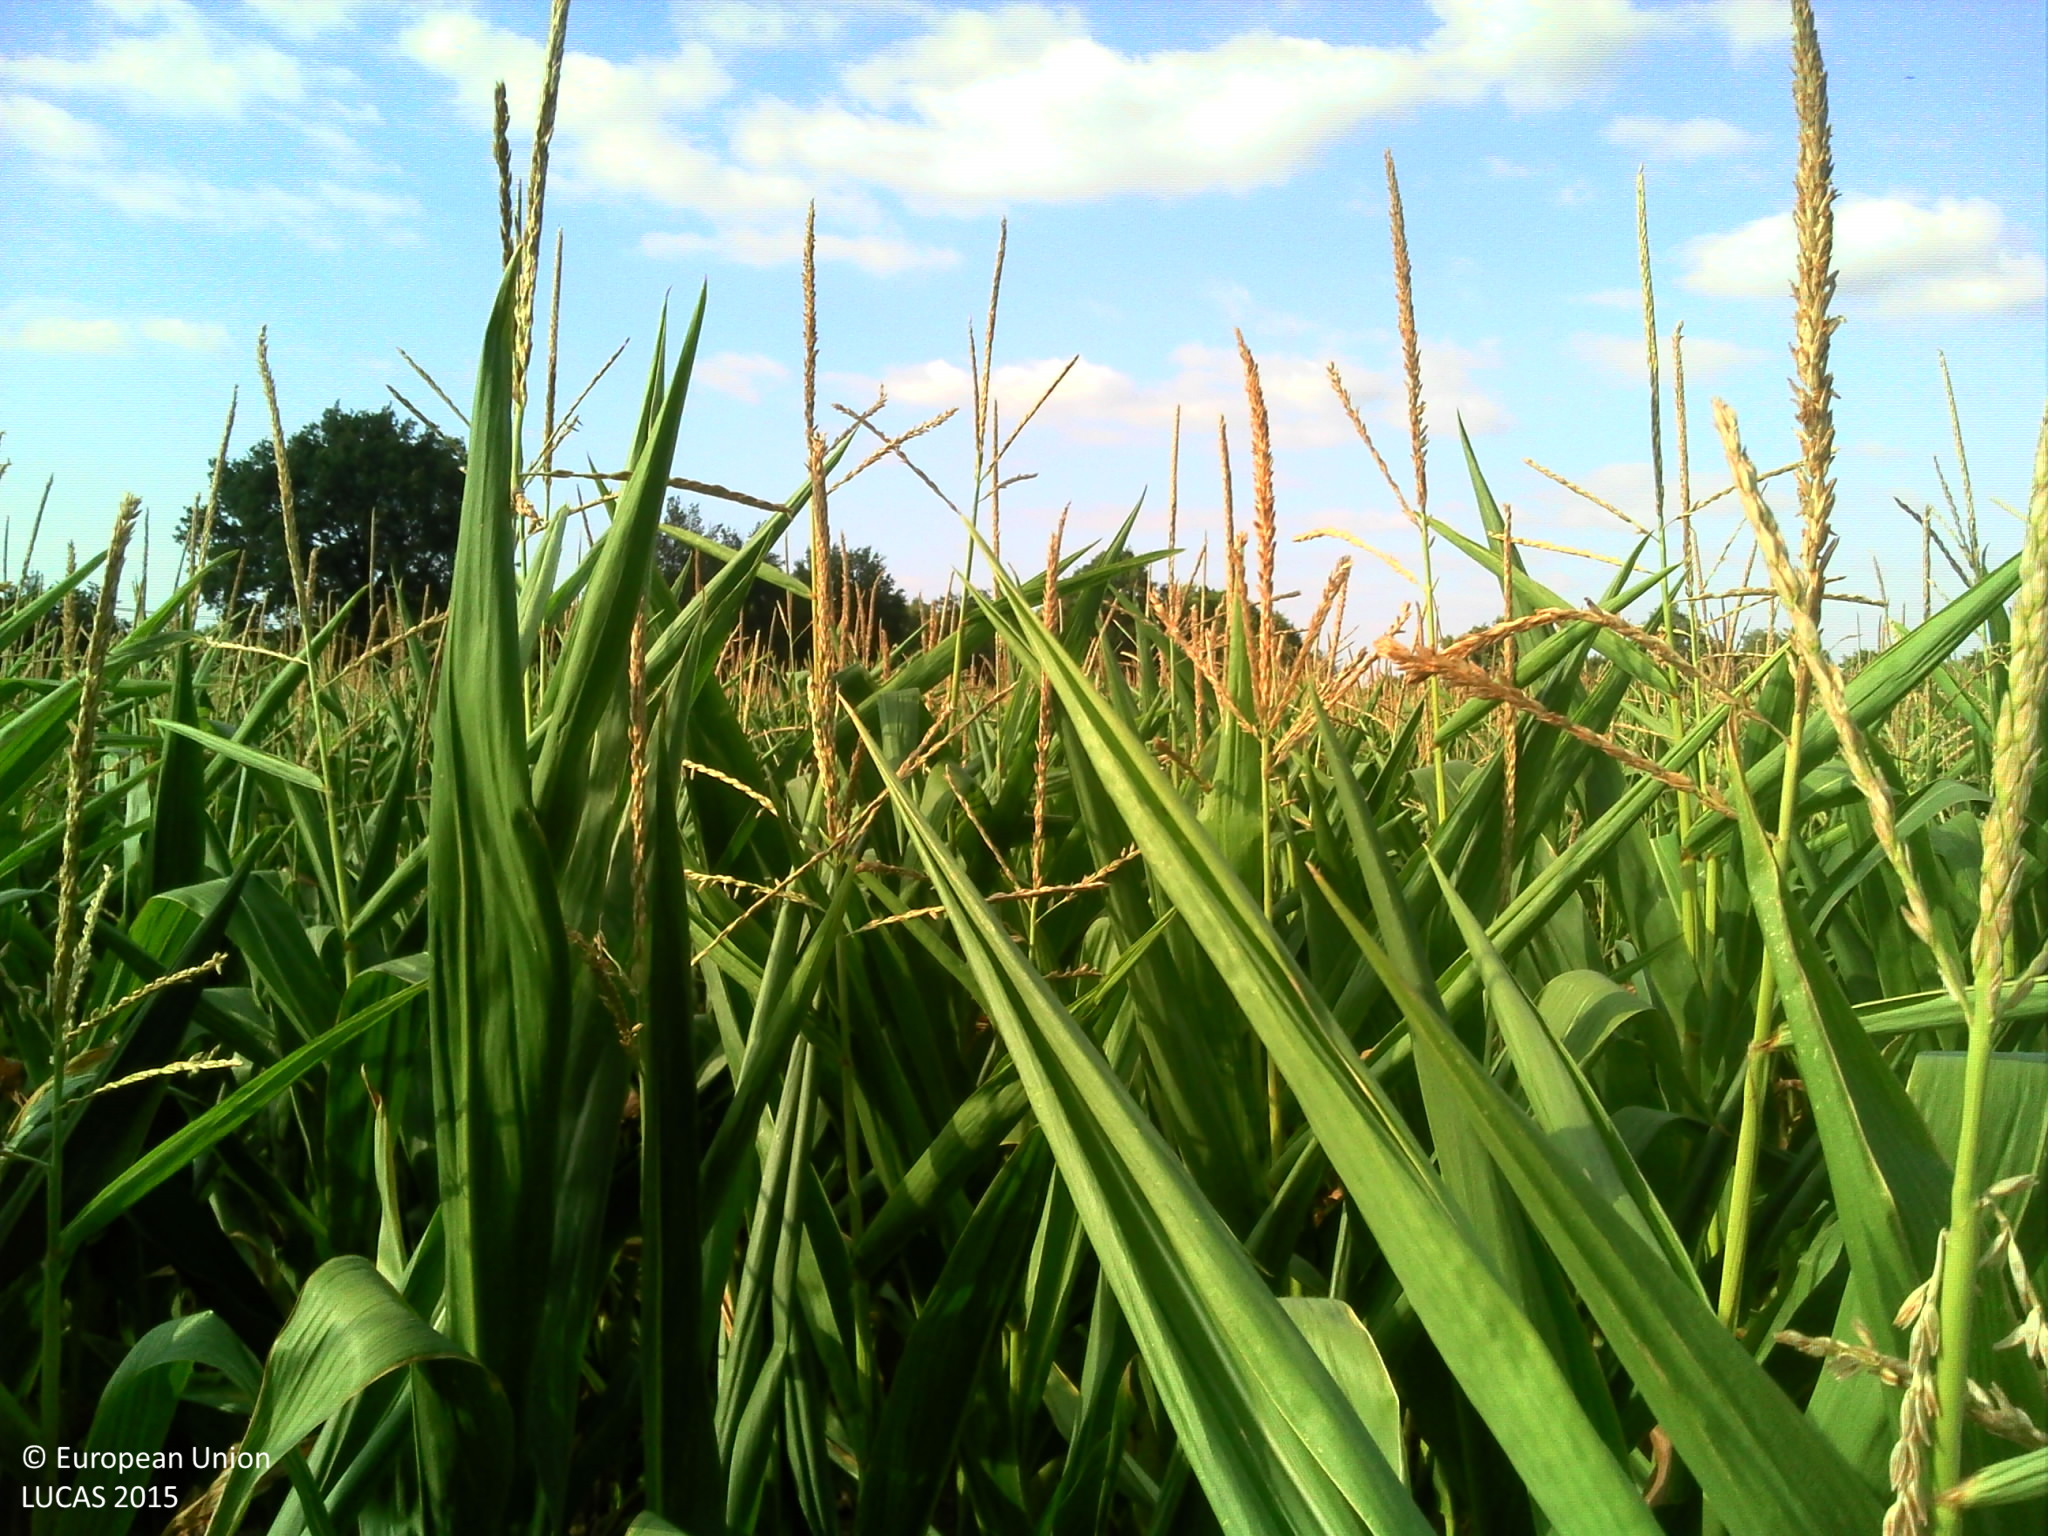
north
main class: Cropland
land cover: Maize
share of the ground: > 75 %
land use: Agriculture (excluding fallow land and kitchen gardens)
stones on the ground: 10 - 25 %
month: August
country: FR
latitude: 46.6577
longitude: -1.3141
